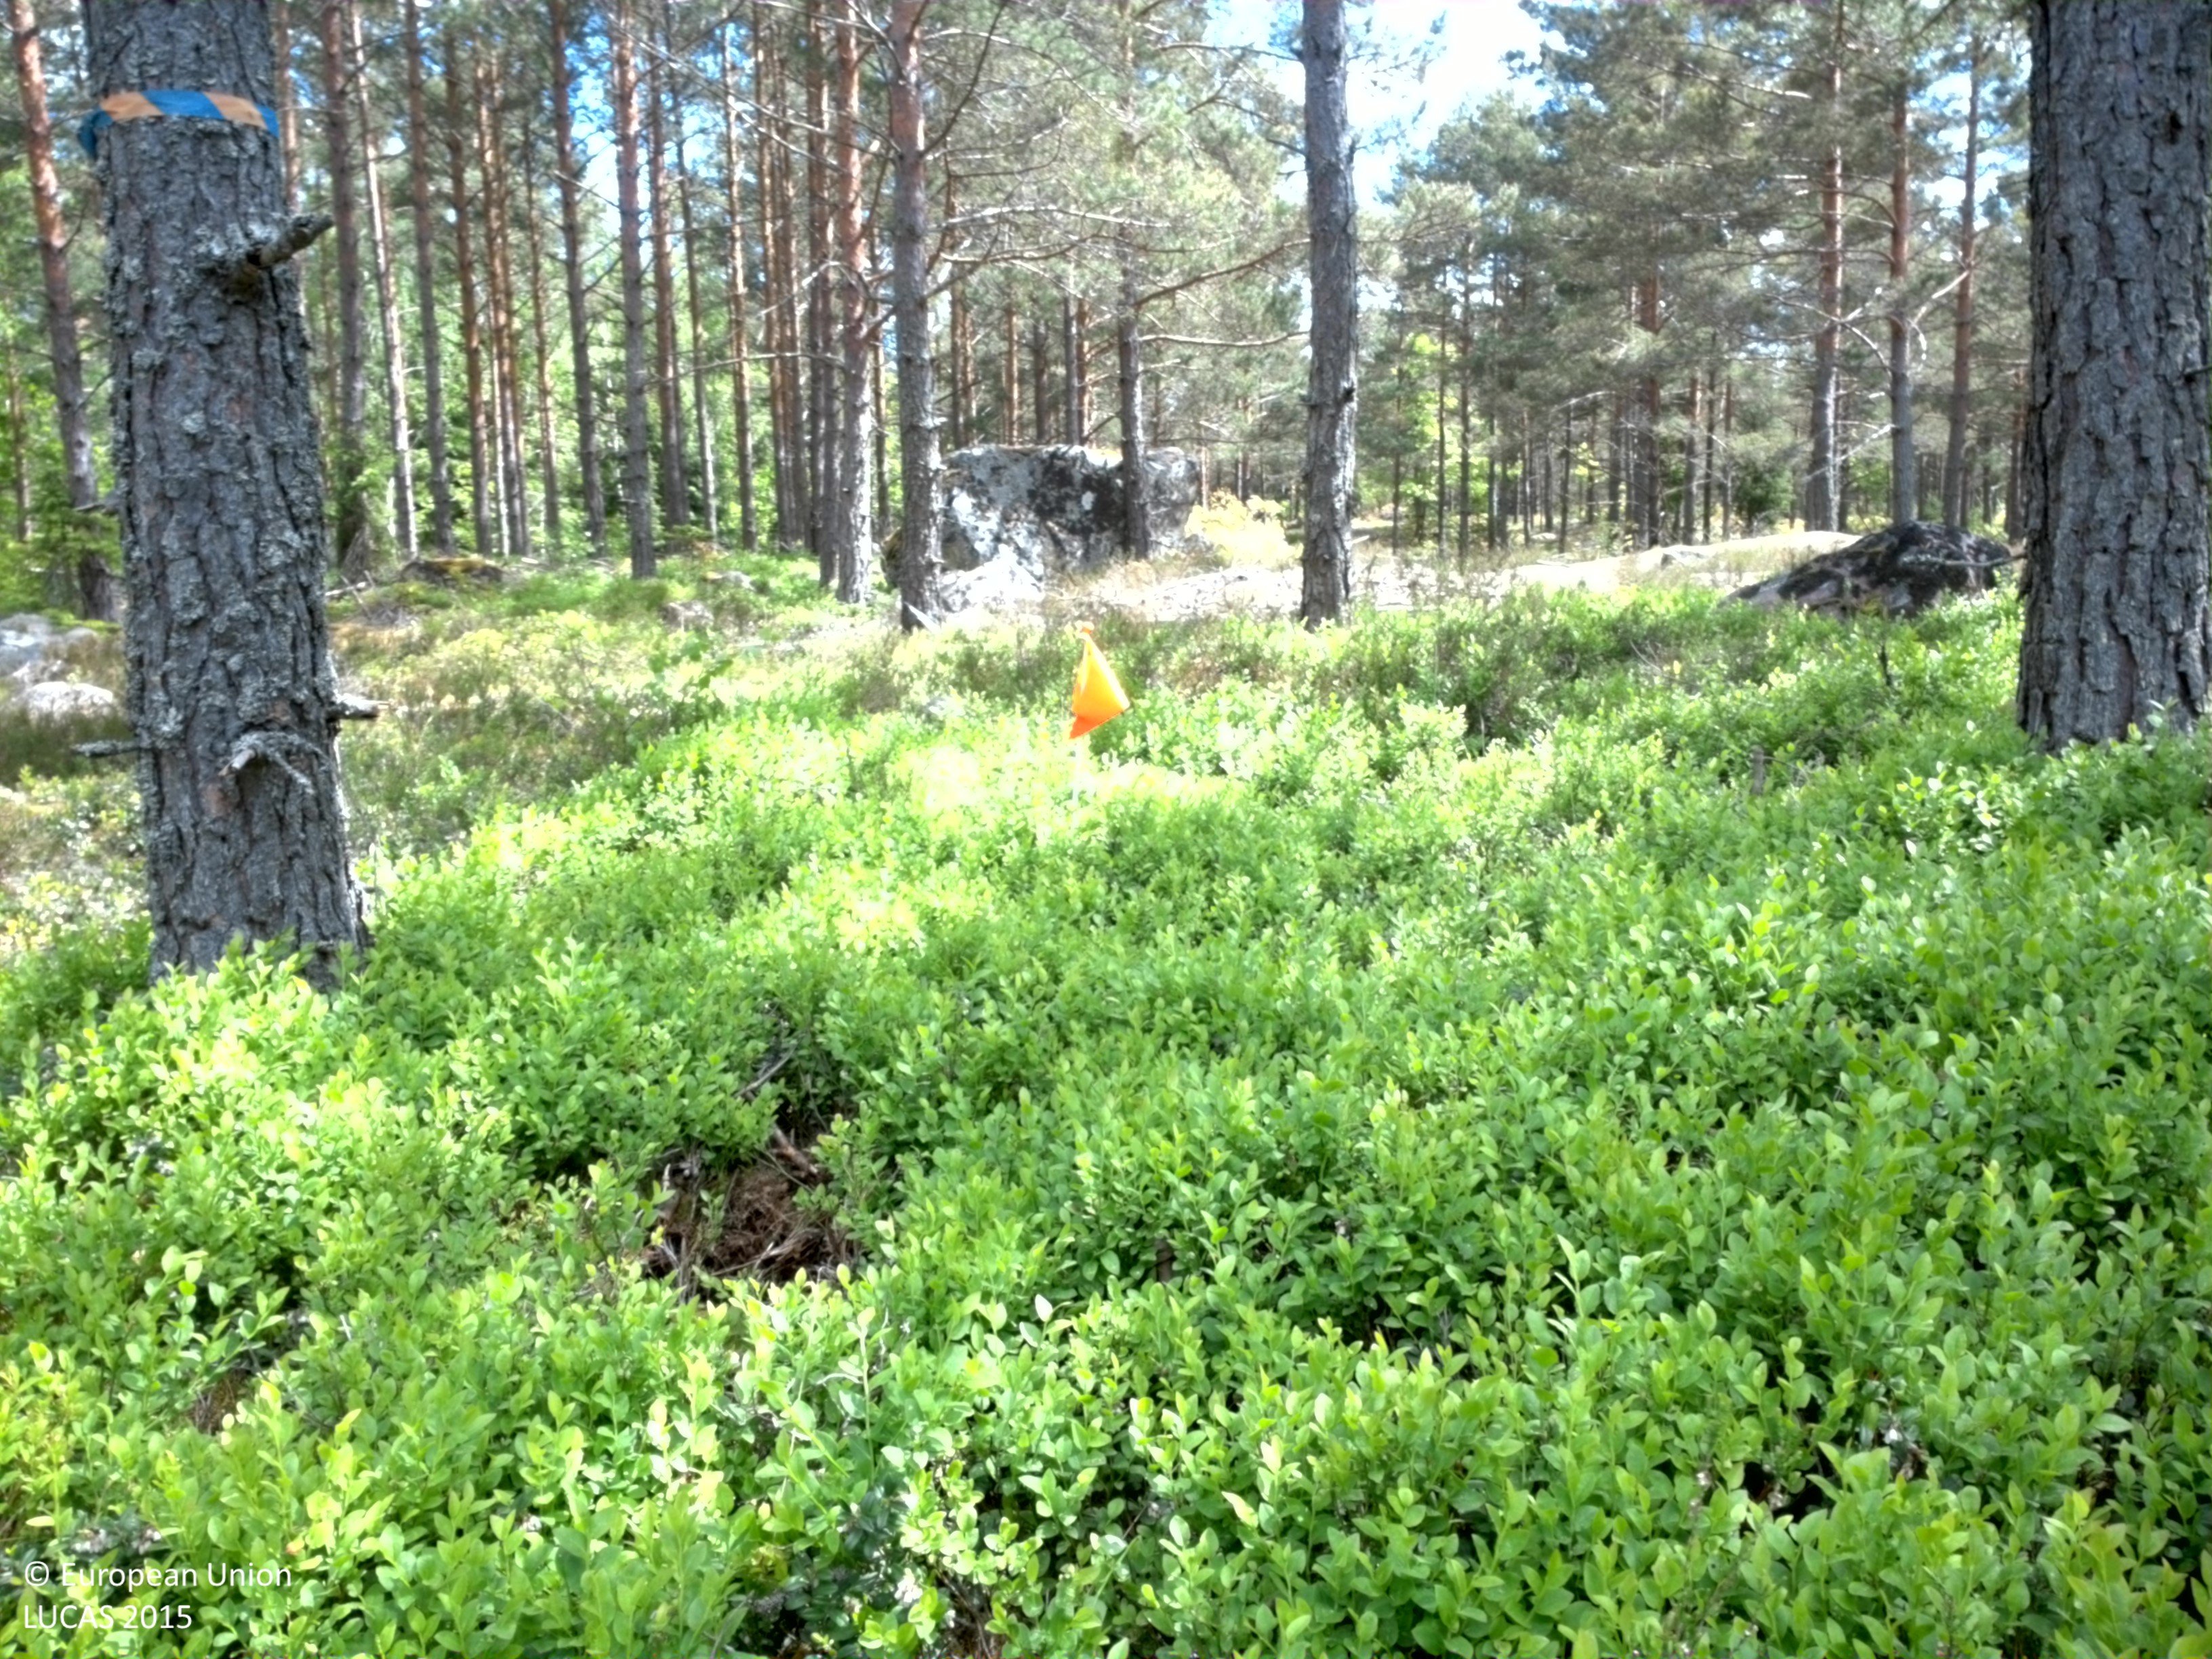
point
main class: Woodland
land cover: Pine dominated coniferous woodland
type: boreal forest
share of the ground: 50 - 75 %
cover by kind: coniferous forest trees 50 %, shrubs 25 %, lichens and mosses 25 %
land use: Forestry
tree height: > 5 m
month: May
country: SE
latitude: 57.1631
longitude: 16.4321
